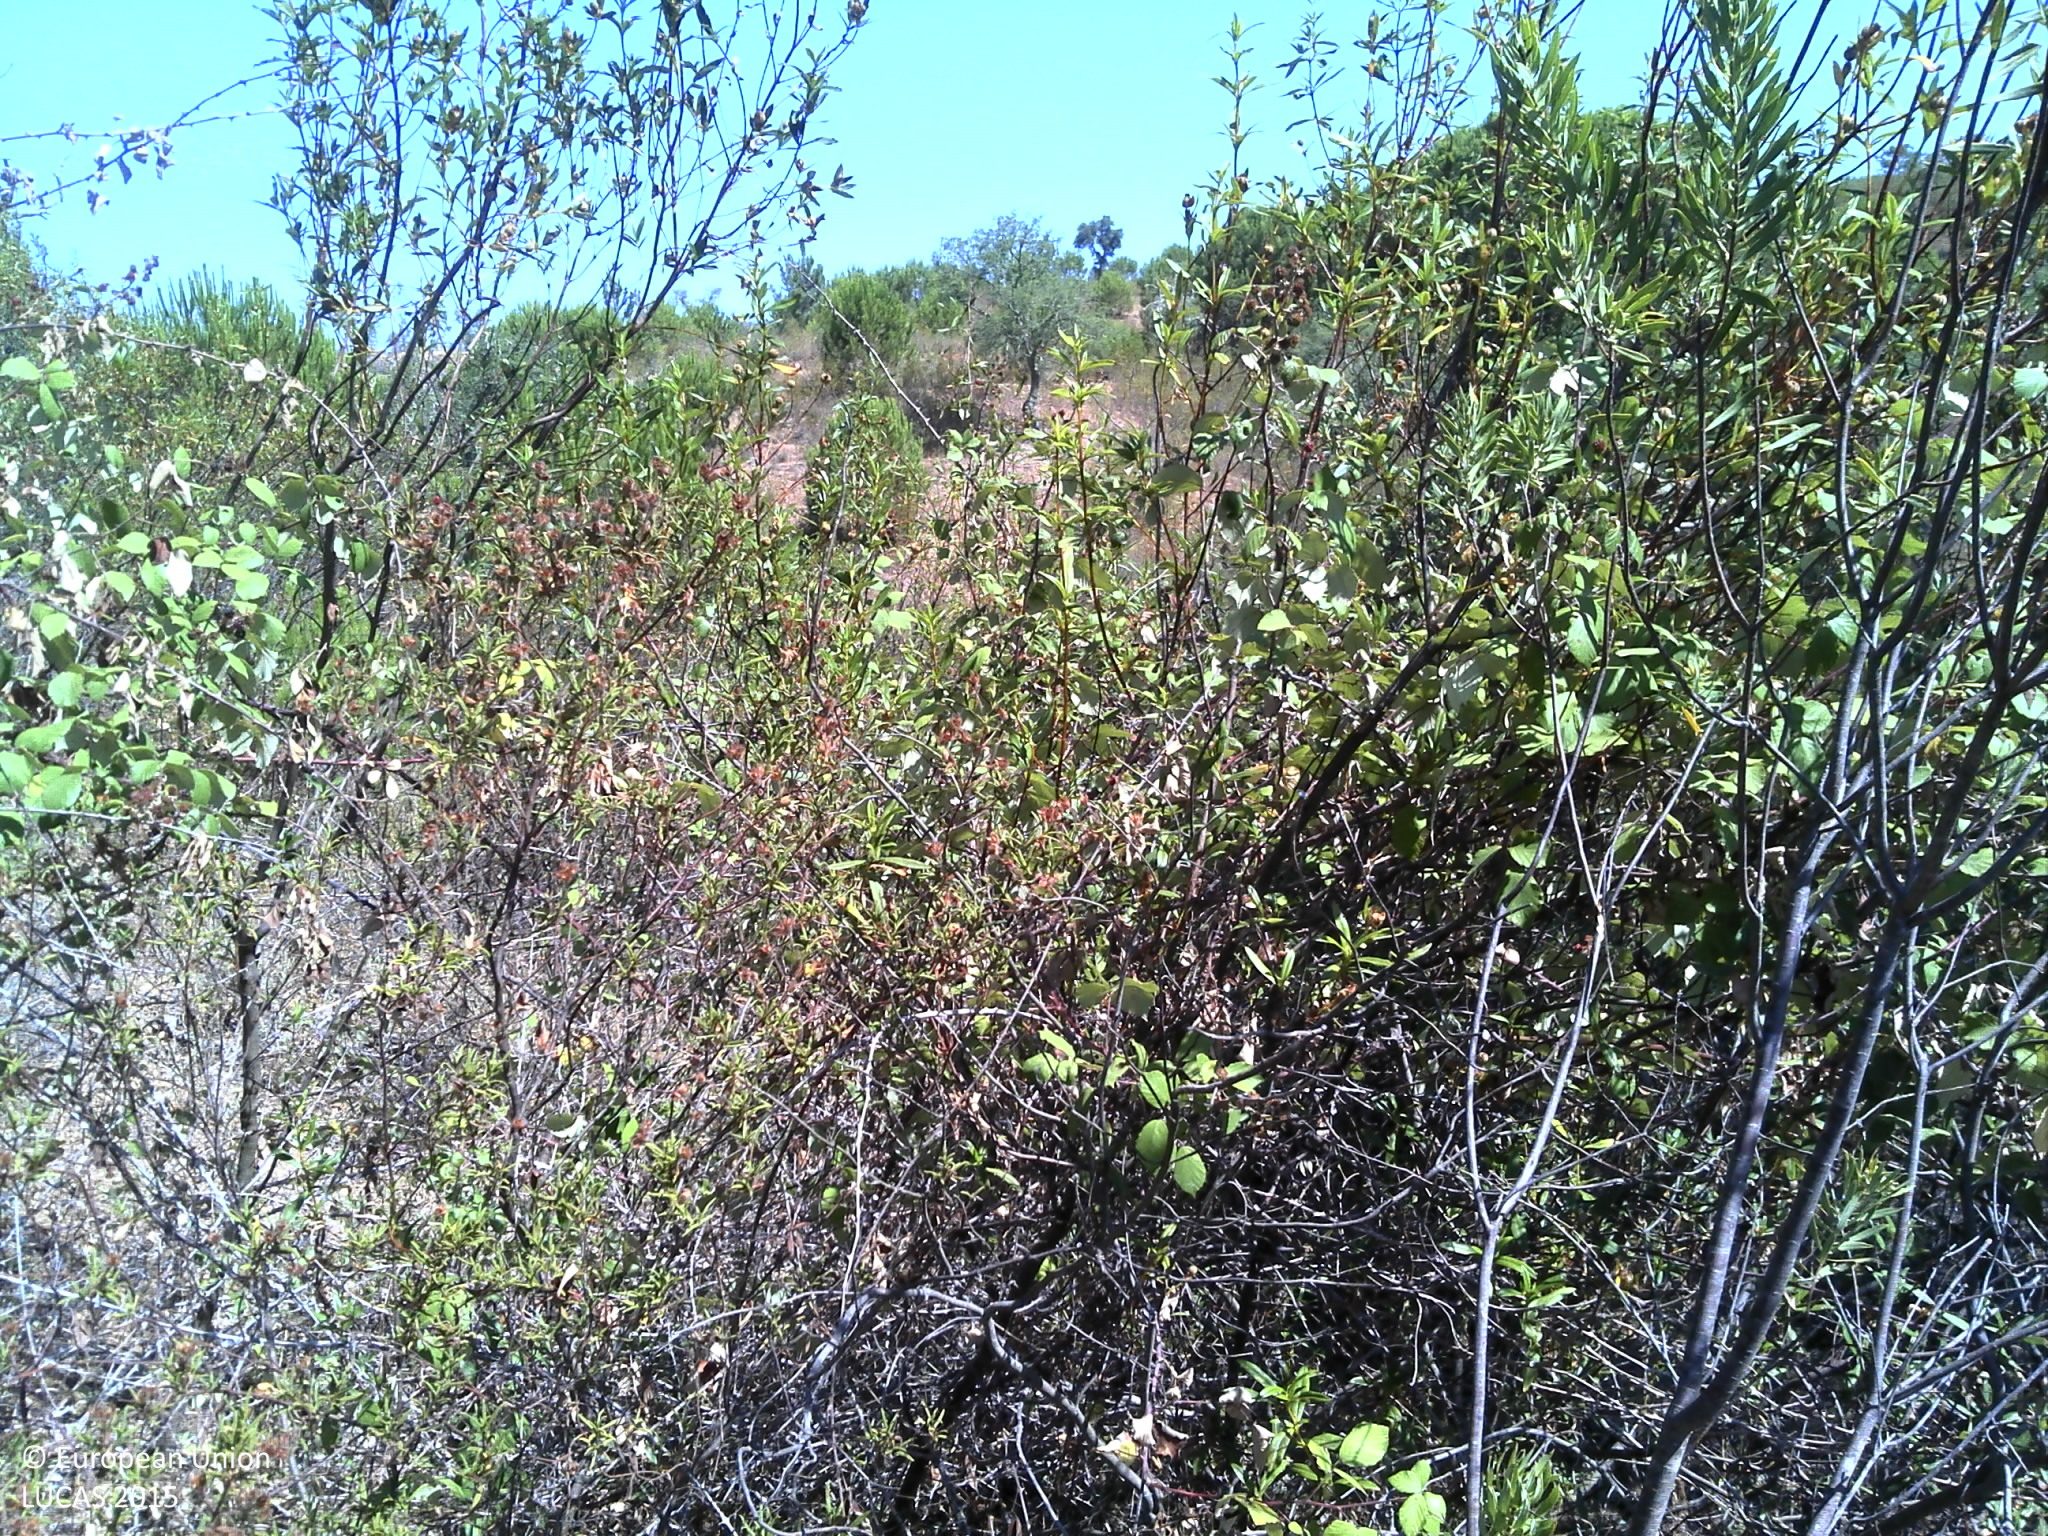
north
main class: Woodland
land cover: Pine dominated mixed woodland
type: coniferous forest of the mediterranean region
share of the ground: 10 - 25 %
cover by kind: shrubs 45 %, coniferous forest trees 25 %, unconsolidated bare surface 20 %, broadleaved forest trees 10 %
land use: Forestry
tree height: > 5 m
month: July
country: PT
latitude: 38.4862
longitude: -8.5222
